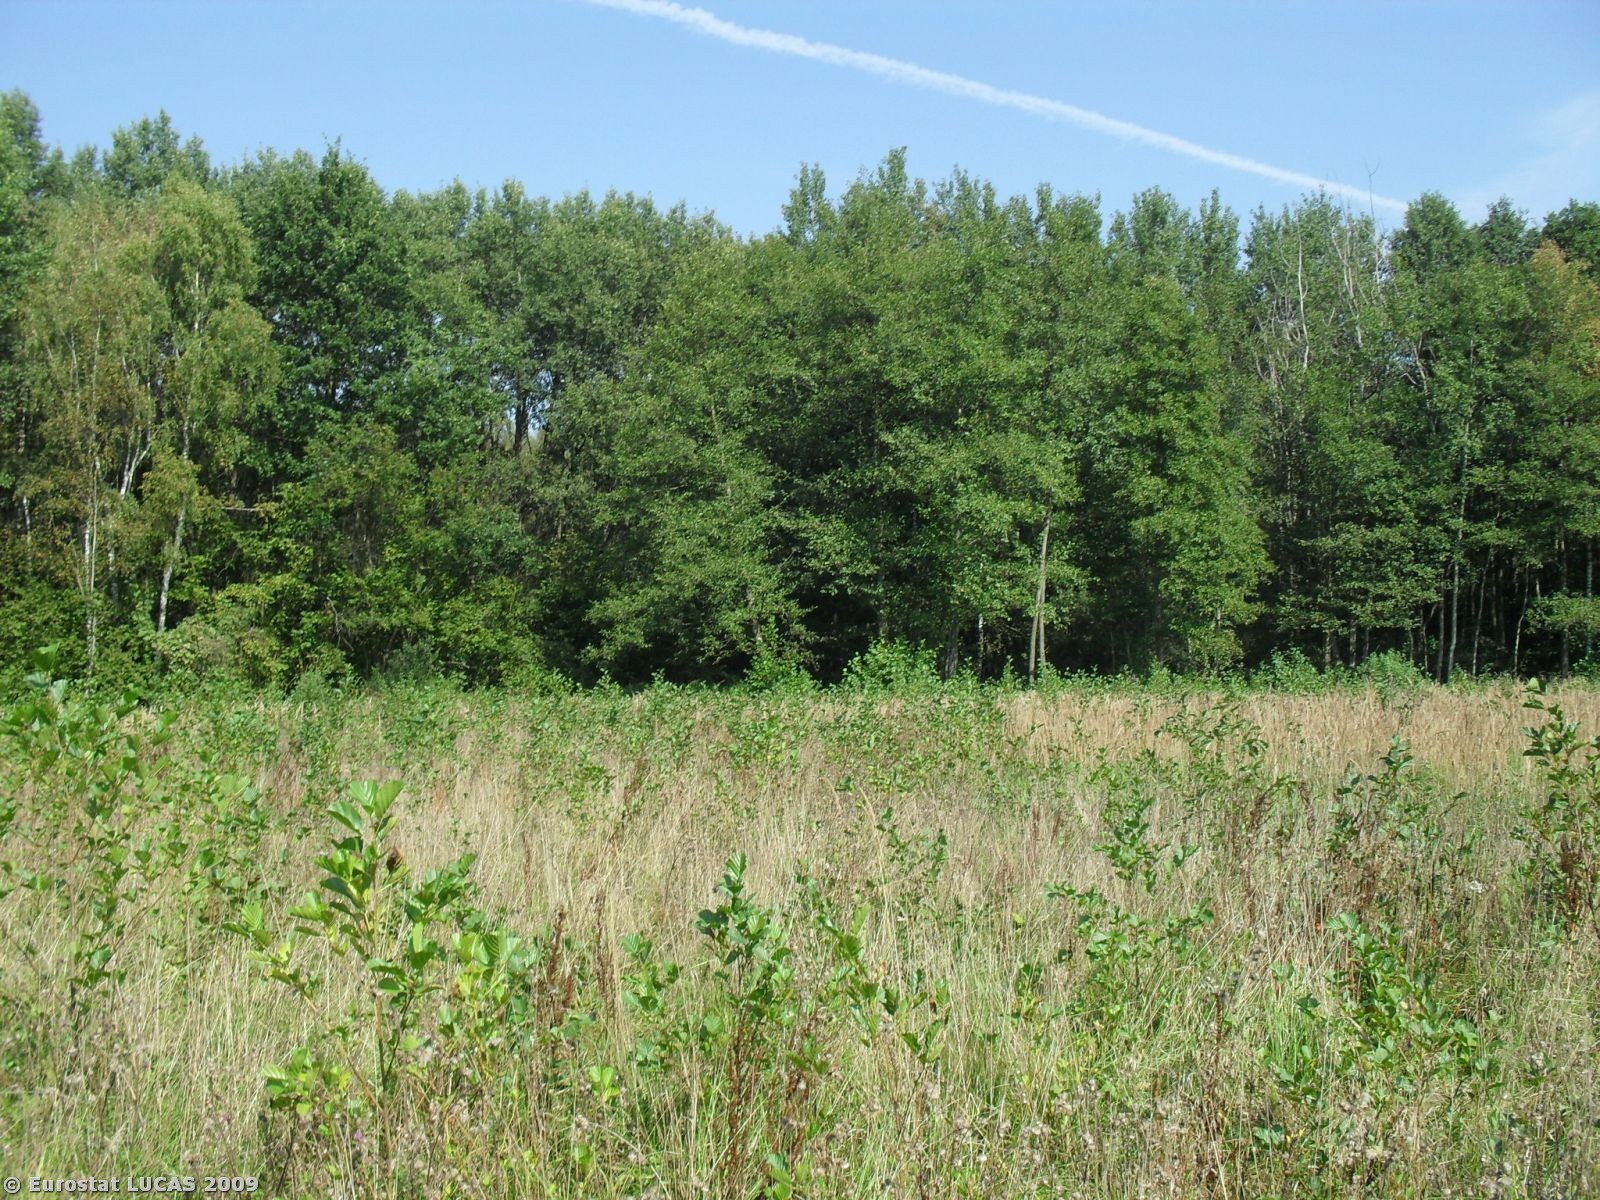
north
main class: Woodland
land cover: Broadleaved woodland
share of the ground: 25 - 50 %
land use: Forestry
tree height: < 5 m
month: September
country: PL
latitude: 50.6027
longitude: 17.2596
